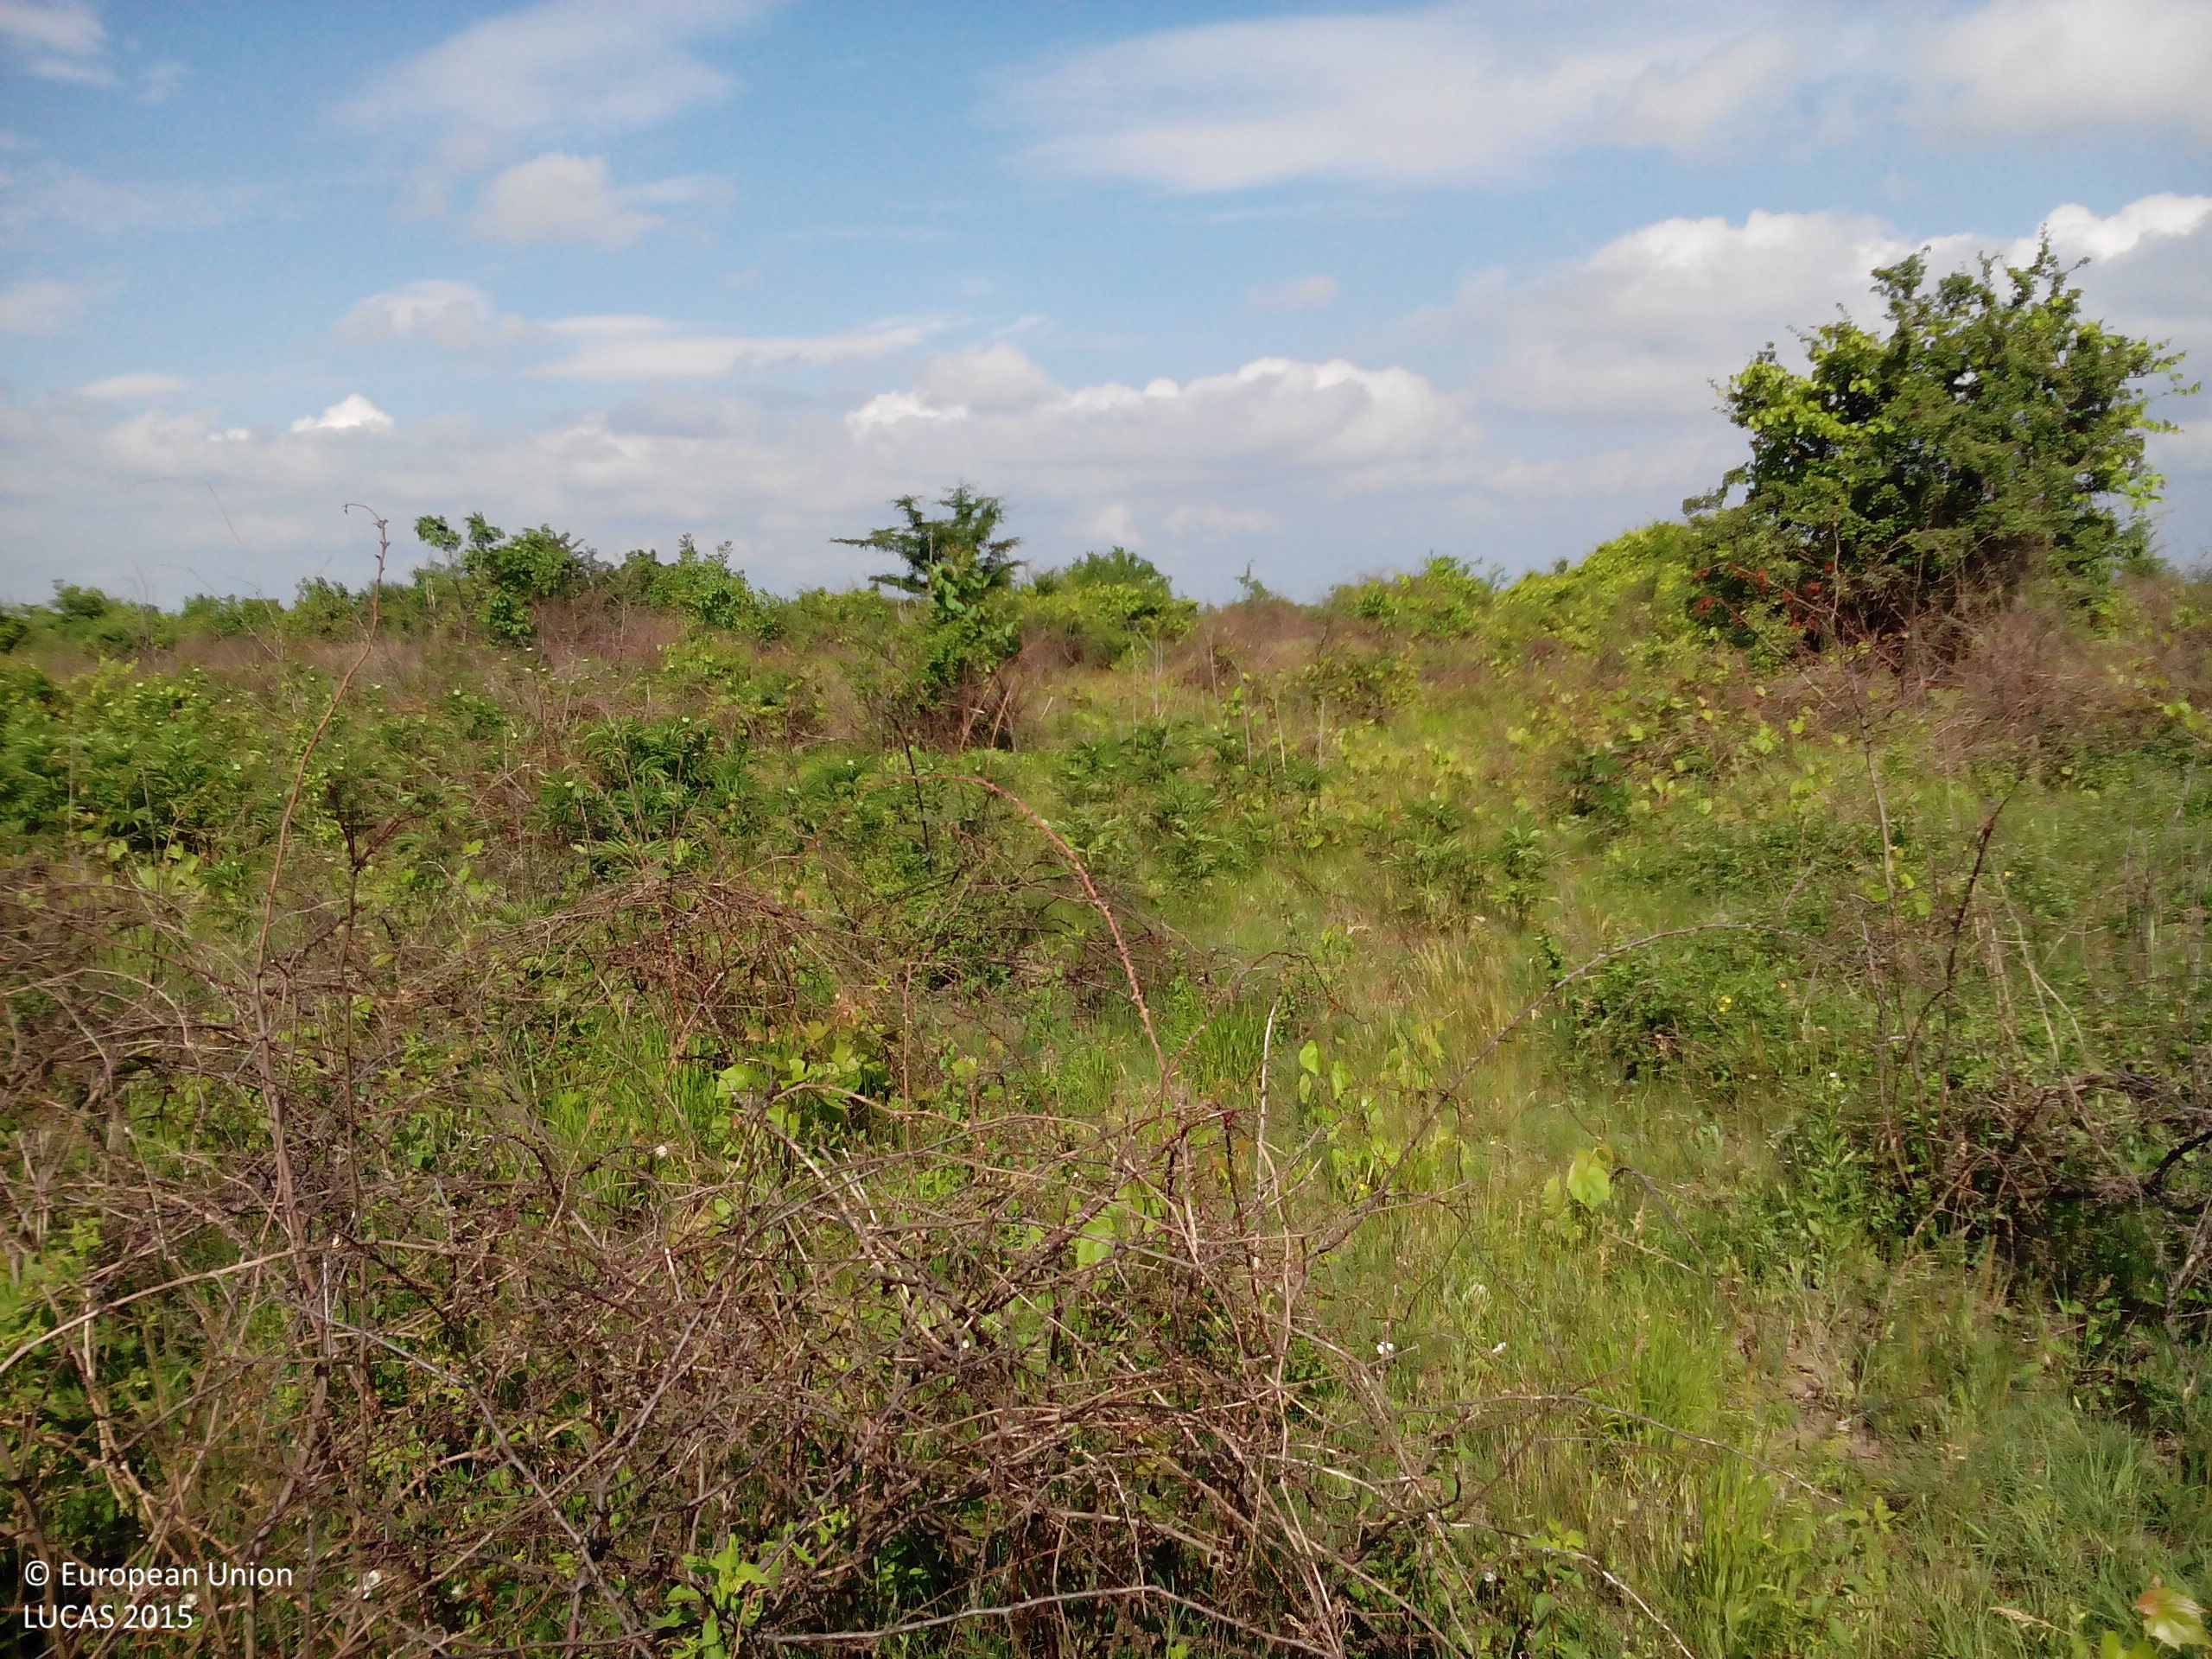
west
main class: Shrubland
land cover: Shrubland with sparse tree cover
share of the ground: > 75 %
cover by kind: shrubs 75 %, herbaceous plants 20 %, broadleaved forest trees 5 %
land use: Fallow land
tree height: < 5 m
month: May
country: BG
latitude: 43.6709
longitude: 24.2598
